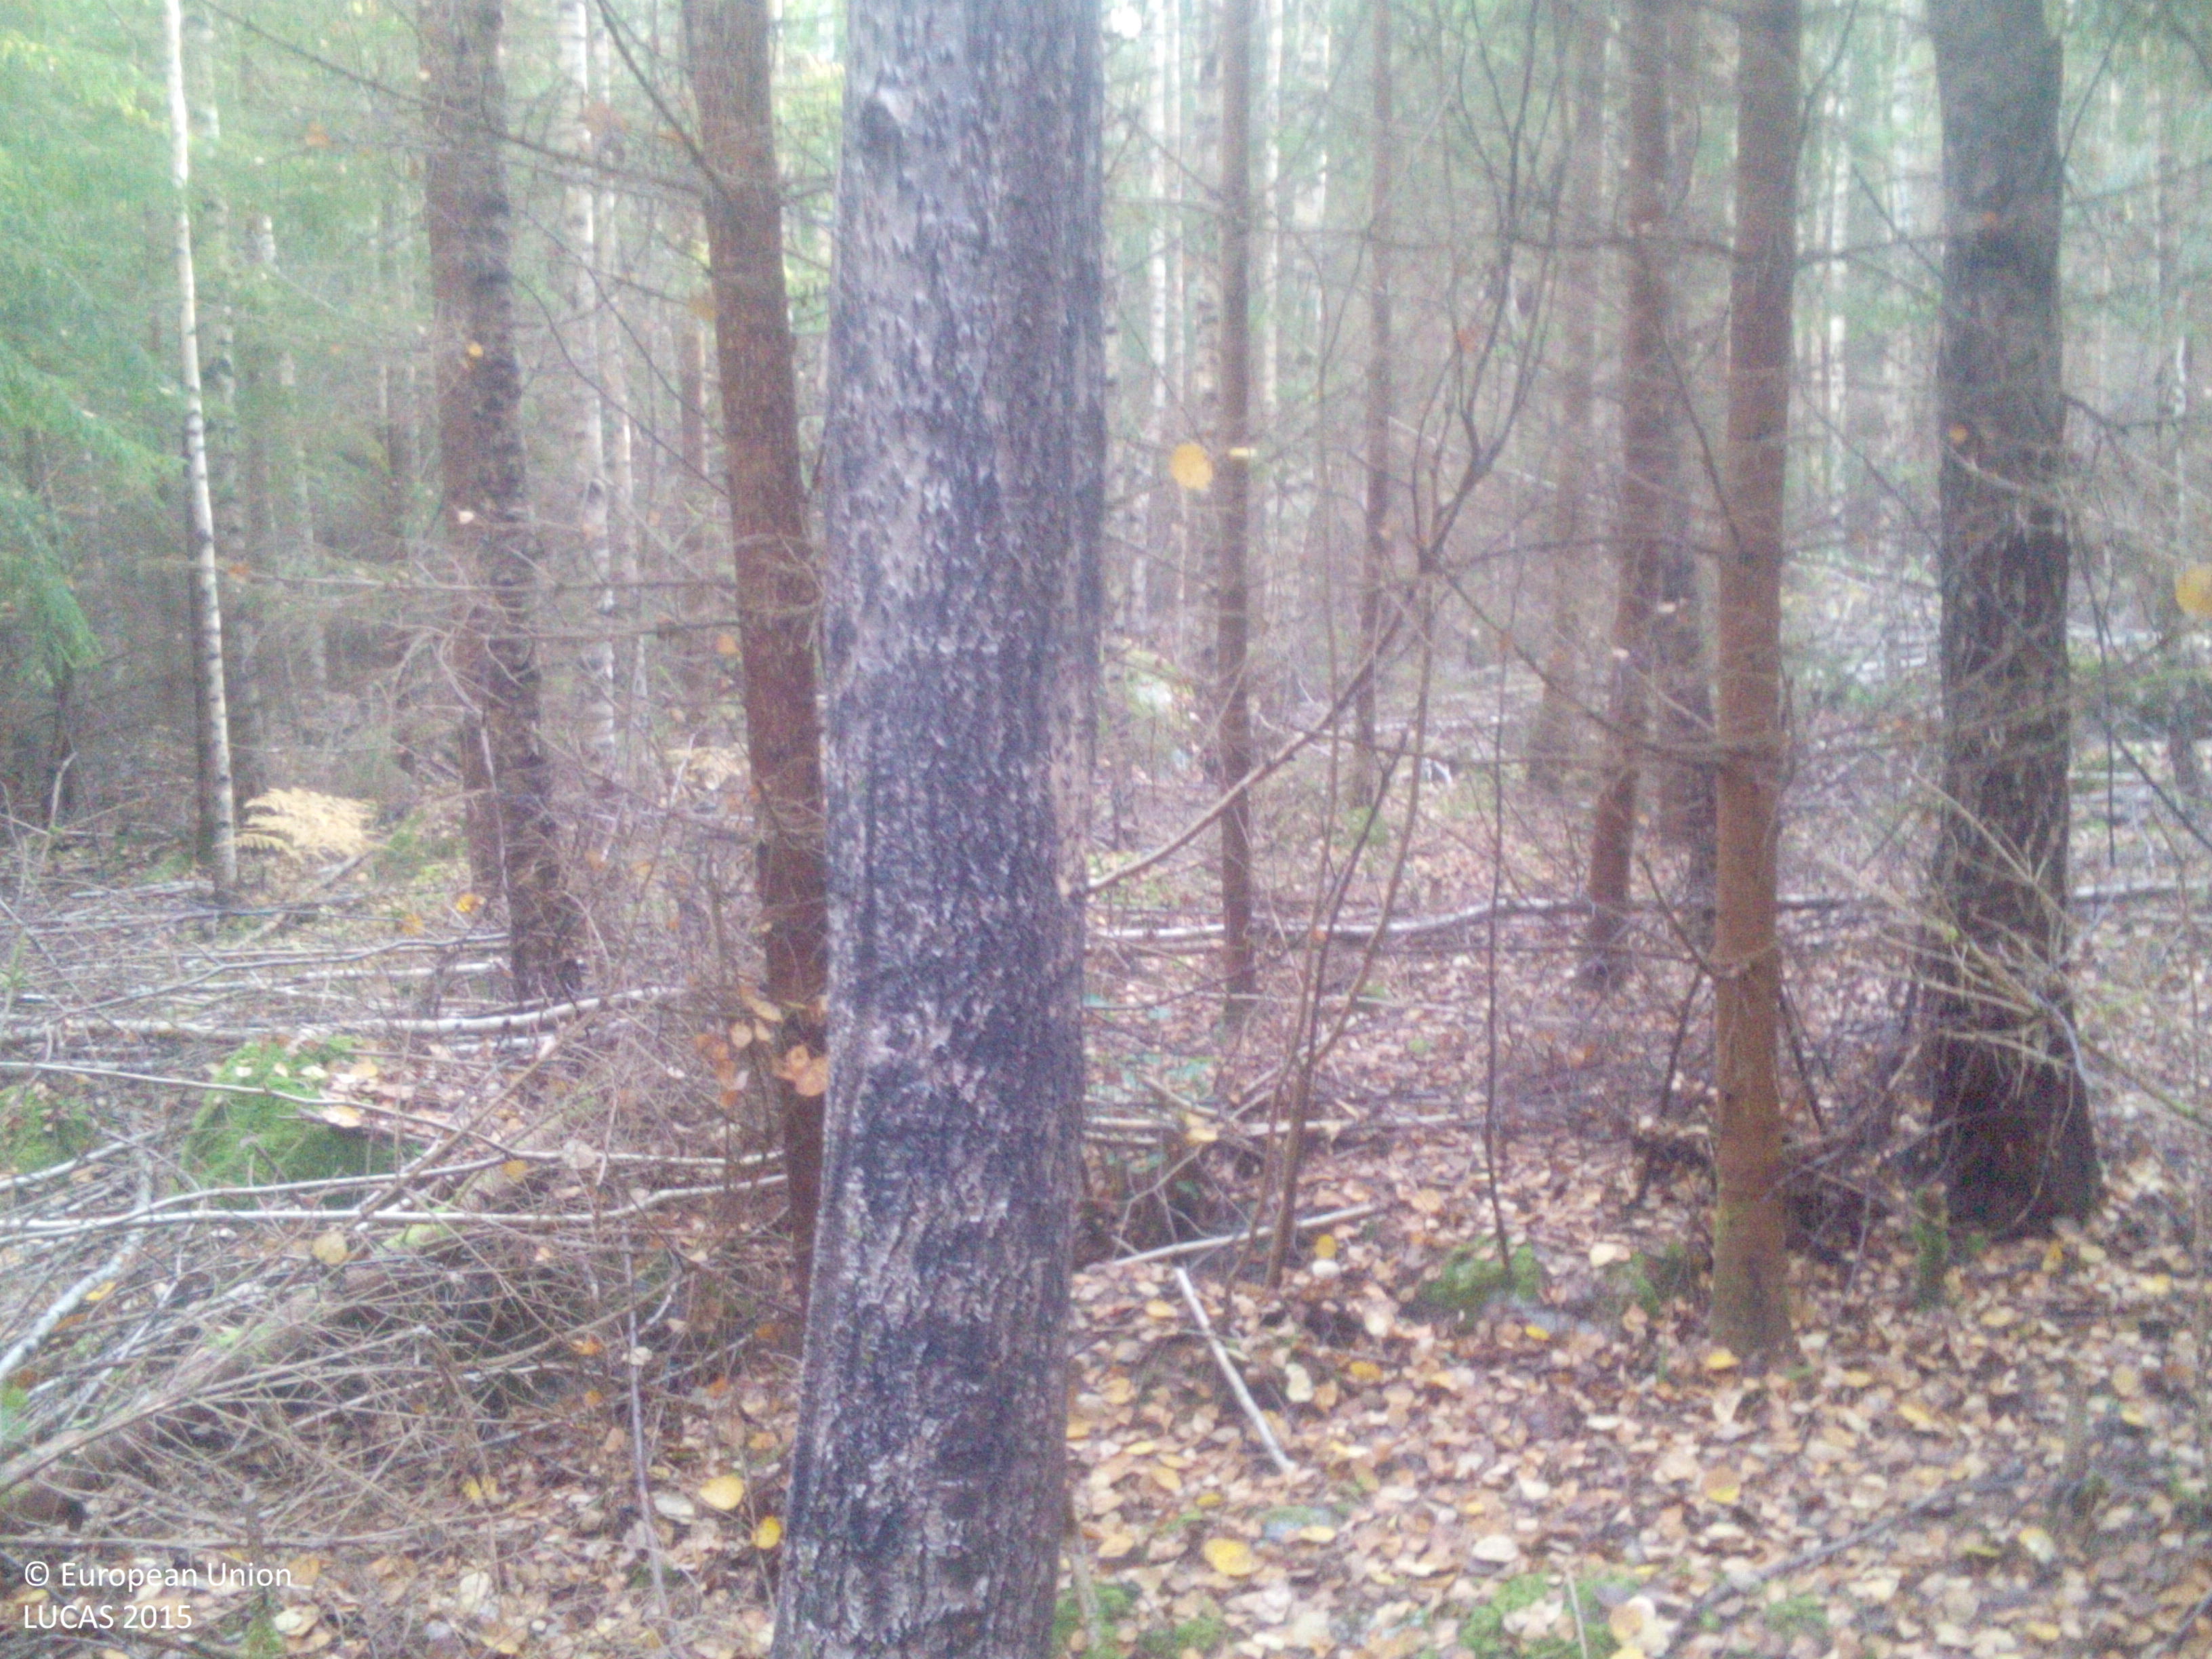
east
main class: Woodland
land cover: Spruce dominated mixed woodland
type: boreal forest
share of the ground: > 75 %
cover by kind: coniferous forest trees 55 %, broadleaved forest trees 40 %, lichens and mosses 5 %
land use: Forestry
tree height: > 5 m
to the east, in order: Spruce dominated mixed woodland; Spruce dominated coniferous woodland
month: October
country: SE
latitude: 58.8943
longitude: 16.4678
